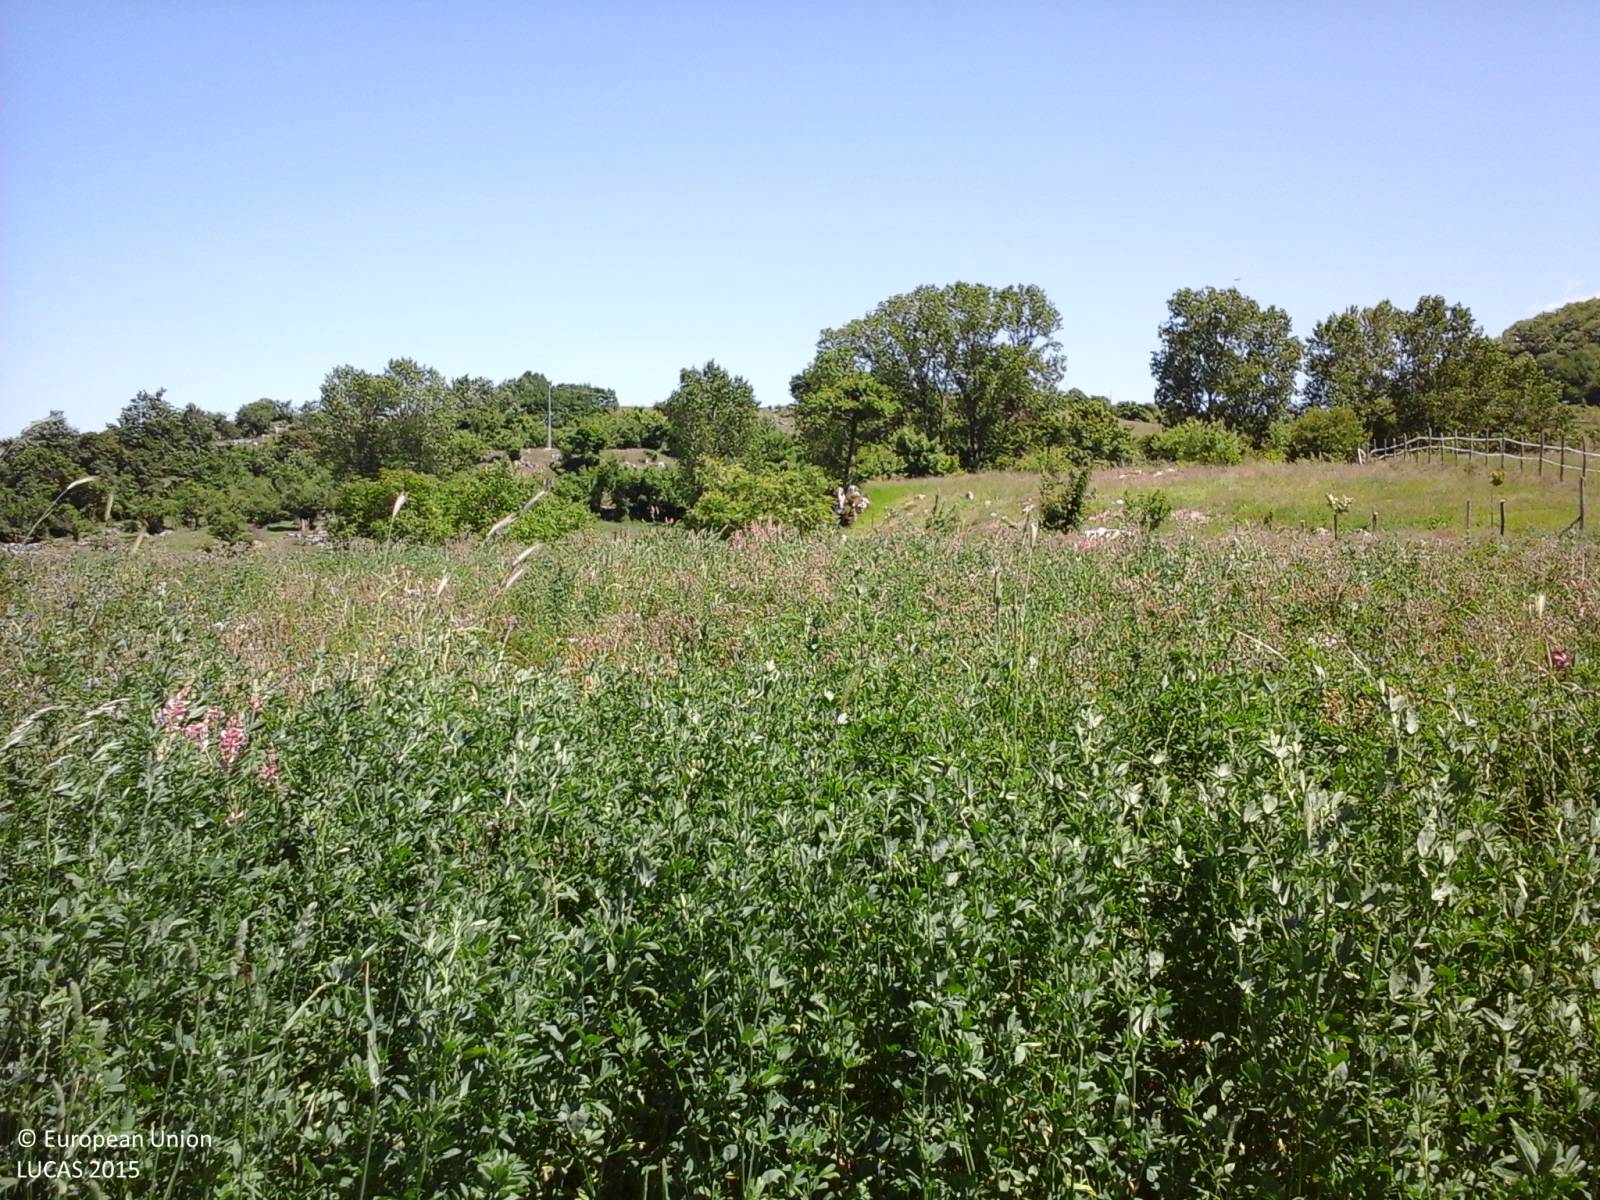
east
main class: Cropland
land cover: Lucerne
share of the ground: > 75 %
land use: Agriculture (excluding fallow land and kitchen gardens)
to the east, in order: Lucerne; Fences; Lucerne; Shrubland with sparse tree cover; Grassland without tree/shrub cover; Broadleaved woodland; Shrubland with sparse tree cover; Broadleaved woodland; Grassland without tree/shrub cover; Broadleaved woodland
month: May
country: IT
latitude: 42.0787
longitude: 13.2163
